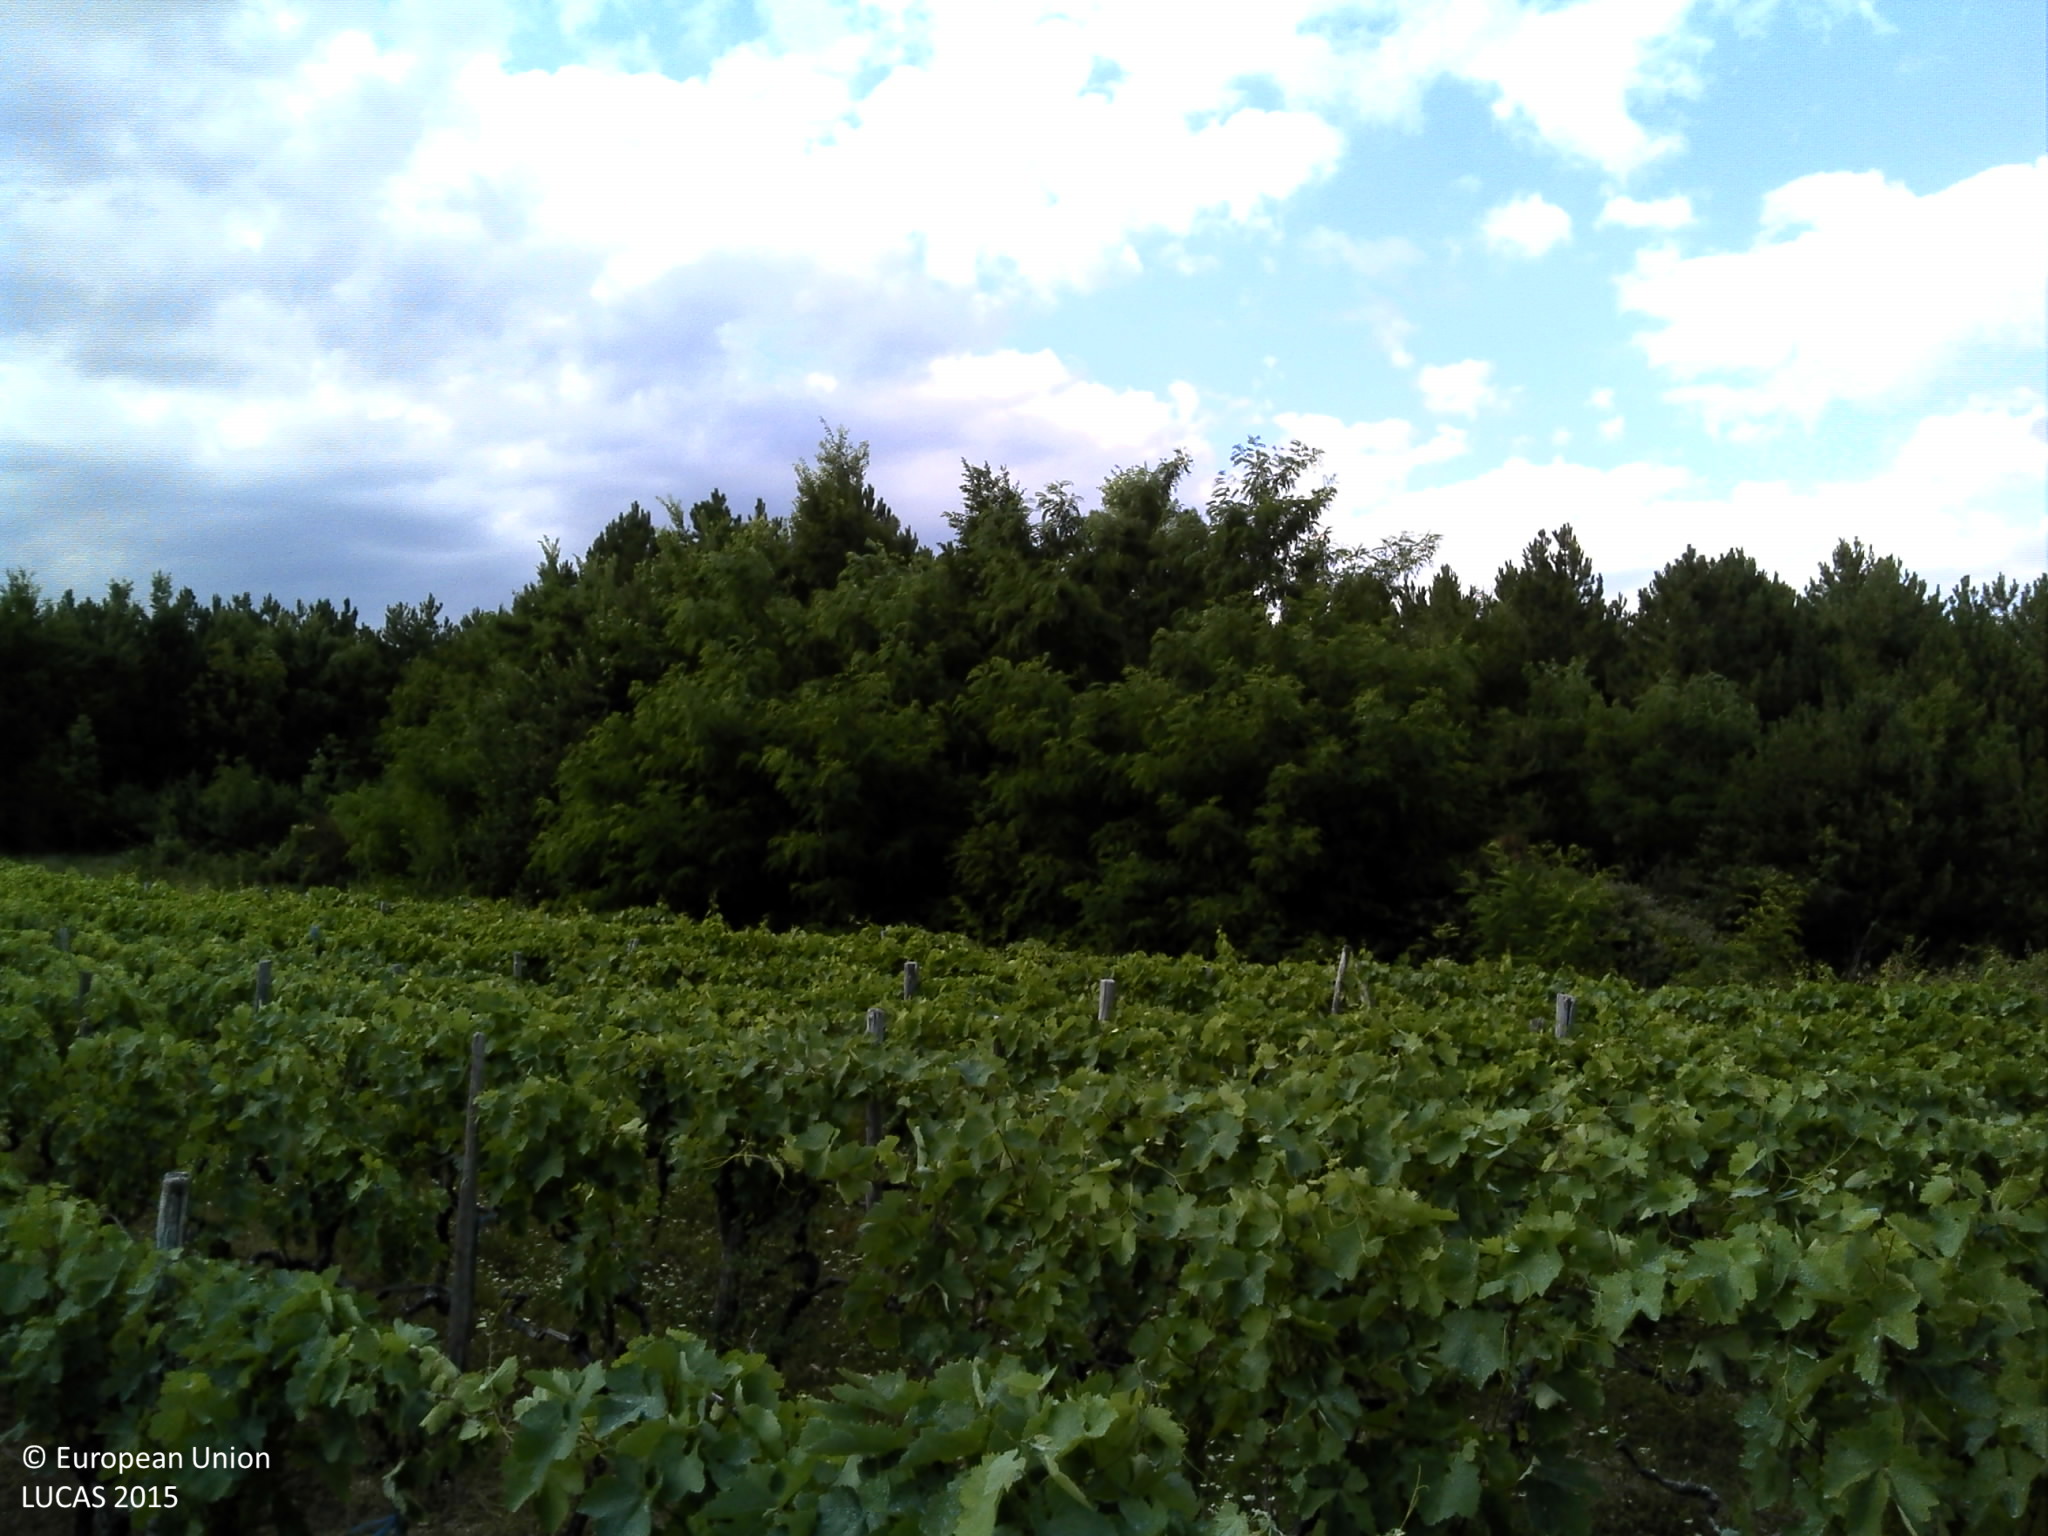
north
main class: Woodland
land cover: Broadleaved woodland
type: thermophilous deciduous forest
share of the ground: 50 - 75 %
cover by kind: broadleaved forest trees 50 %, shrubs 40 %, coniferous forest trees 10 %
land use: Semi-natural and natural areas not in use
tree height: > 5 m
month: June
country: HR
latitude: 44.0748
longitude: 16.1985
